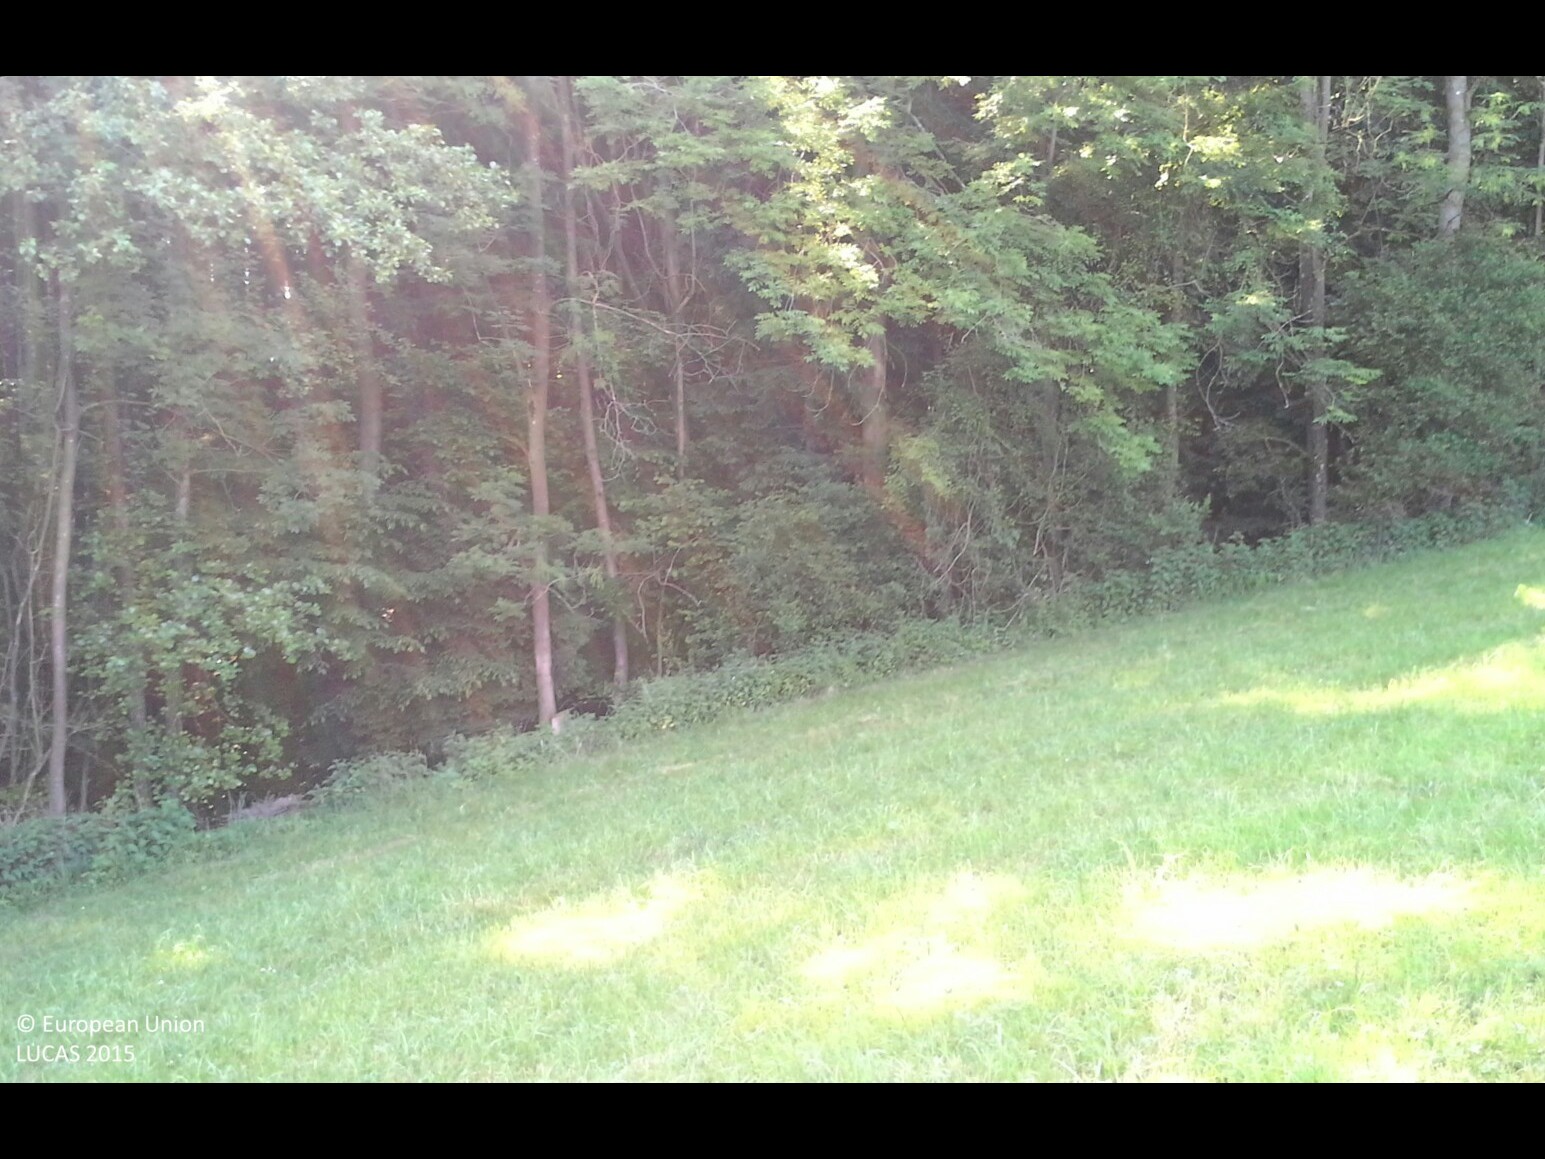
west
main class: Grassland
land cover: Grassland without tree/shrub cover
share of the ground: > 75 %
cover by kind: herbaceous plants 100 %
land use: Agriculture (excluding fallow land and kitchen gardens)
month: June
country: AT
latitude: 48.1024
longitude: 14.7679
